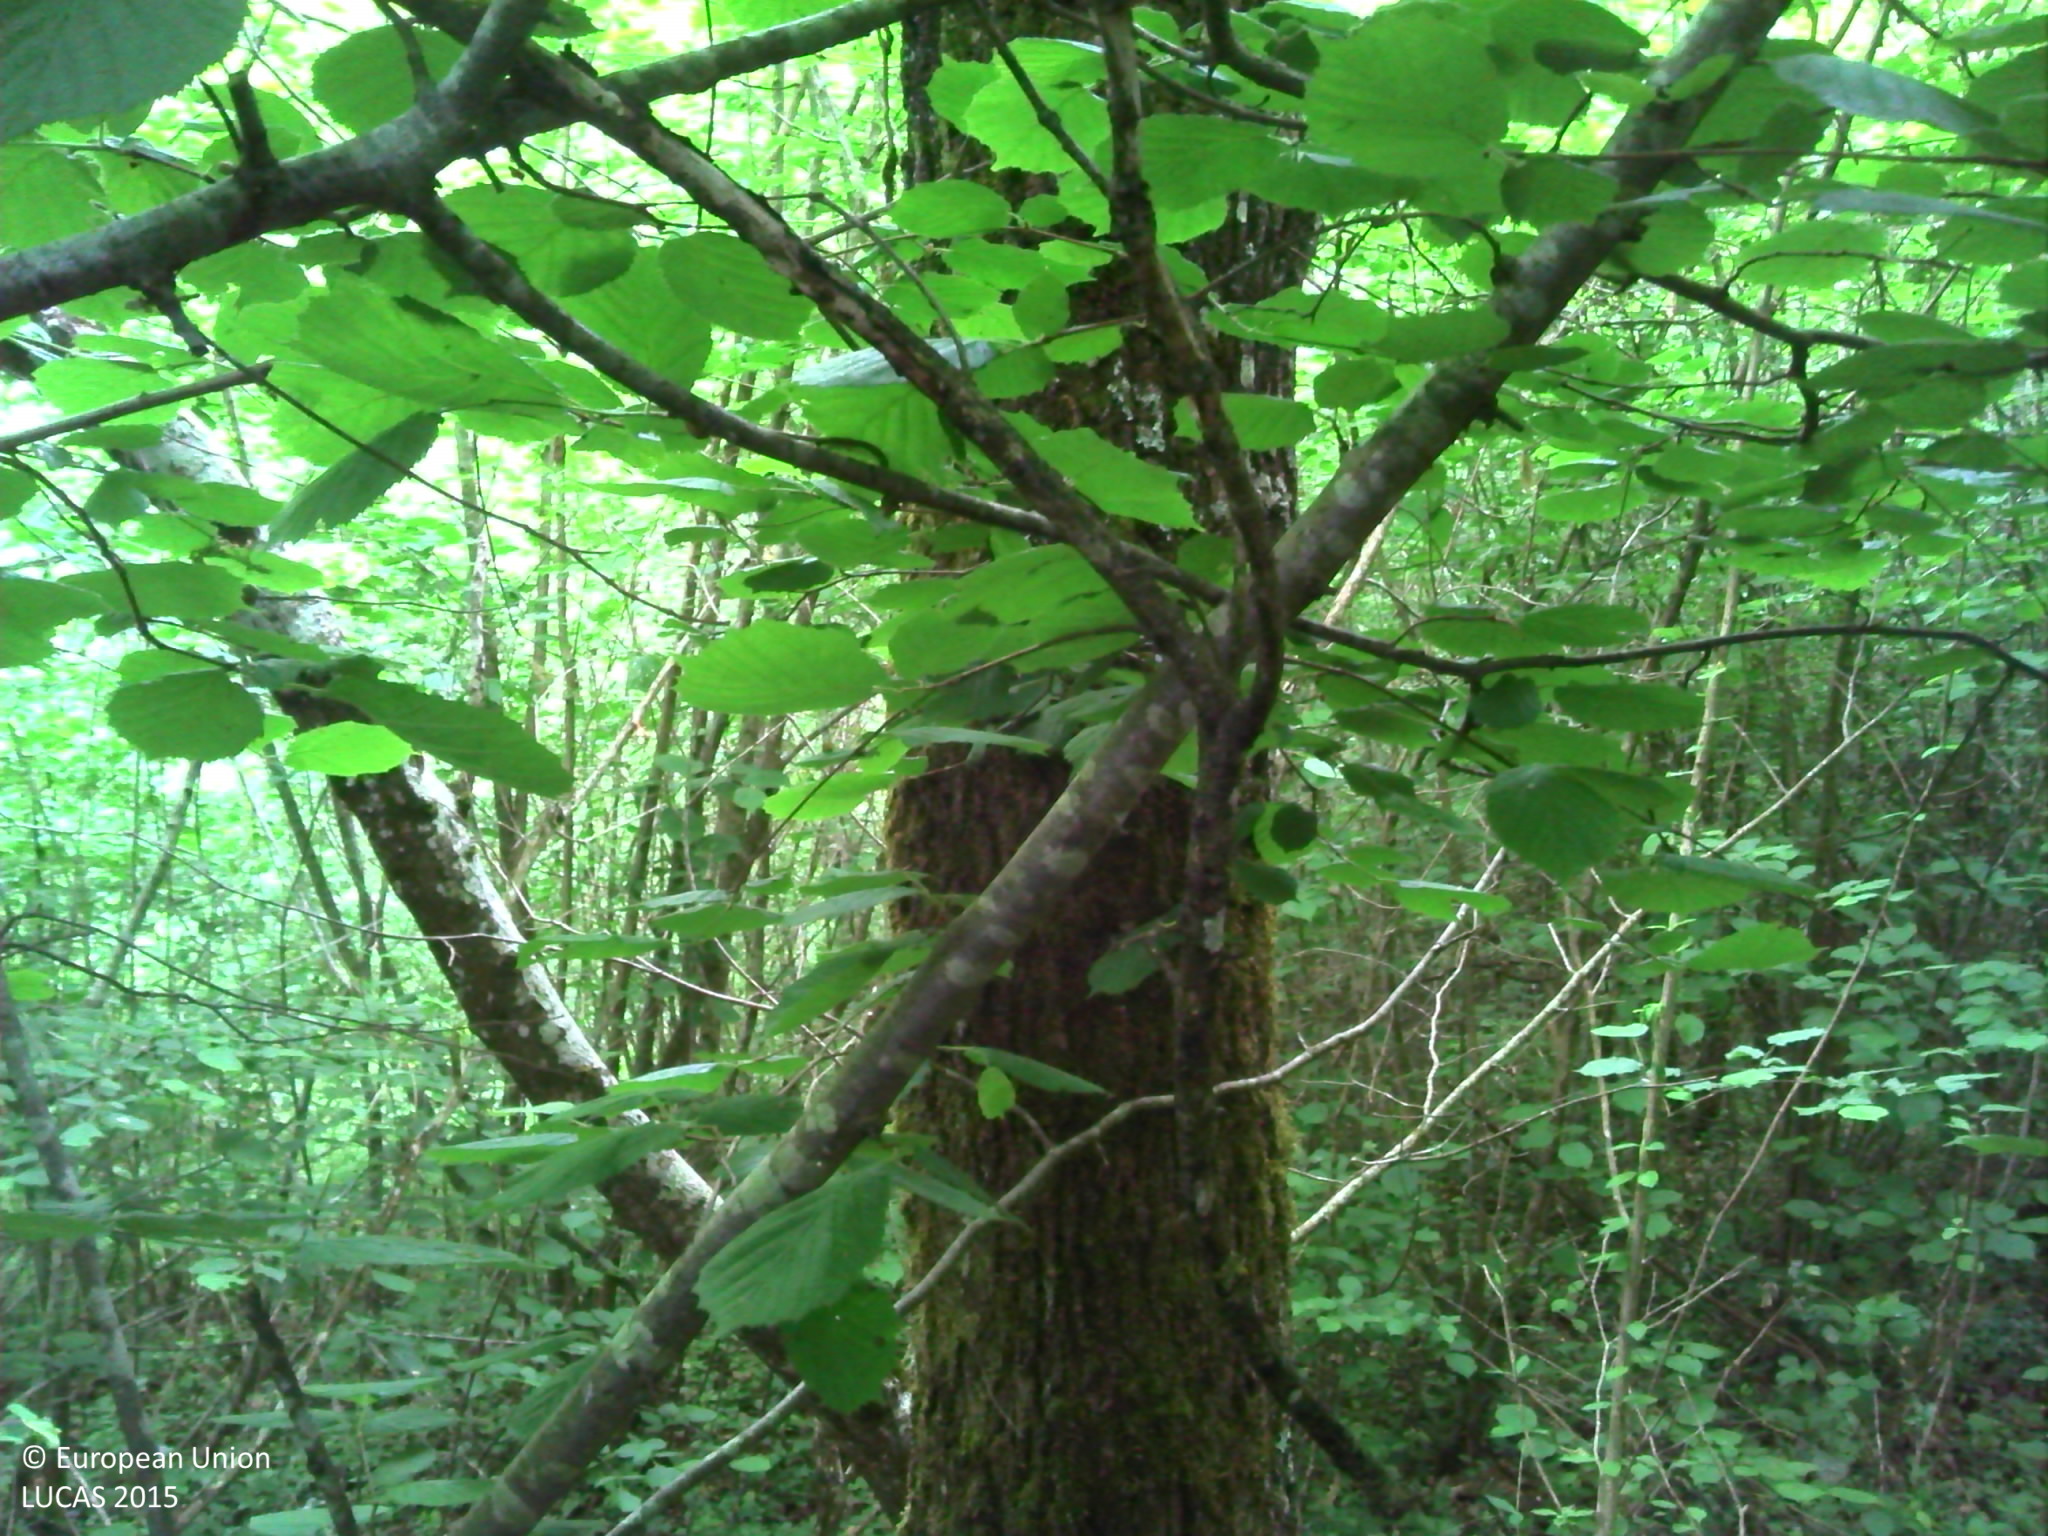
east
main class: Woodland
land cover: Broadleaved woodland
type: thermophilous deciduous forest
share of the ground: > 75 %
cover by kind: broadleaved forest trees 90 %, herbaceous plants 5 %, lichens and mosses 5 %
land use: Forestry
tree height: > 5 m
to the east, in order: Broadleaved woodland; Rivers and streams; Broadleaved woodland; Grass margins; Broadleaved woodland; Grassland without tree/shrub cover; Durum wheat
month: June
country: FR
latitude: 43.6049
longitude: 0.6945
